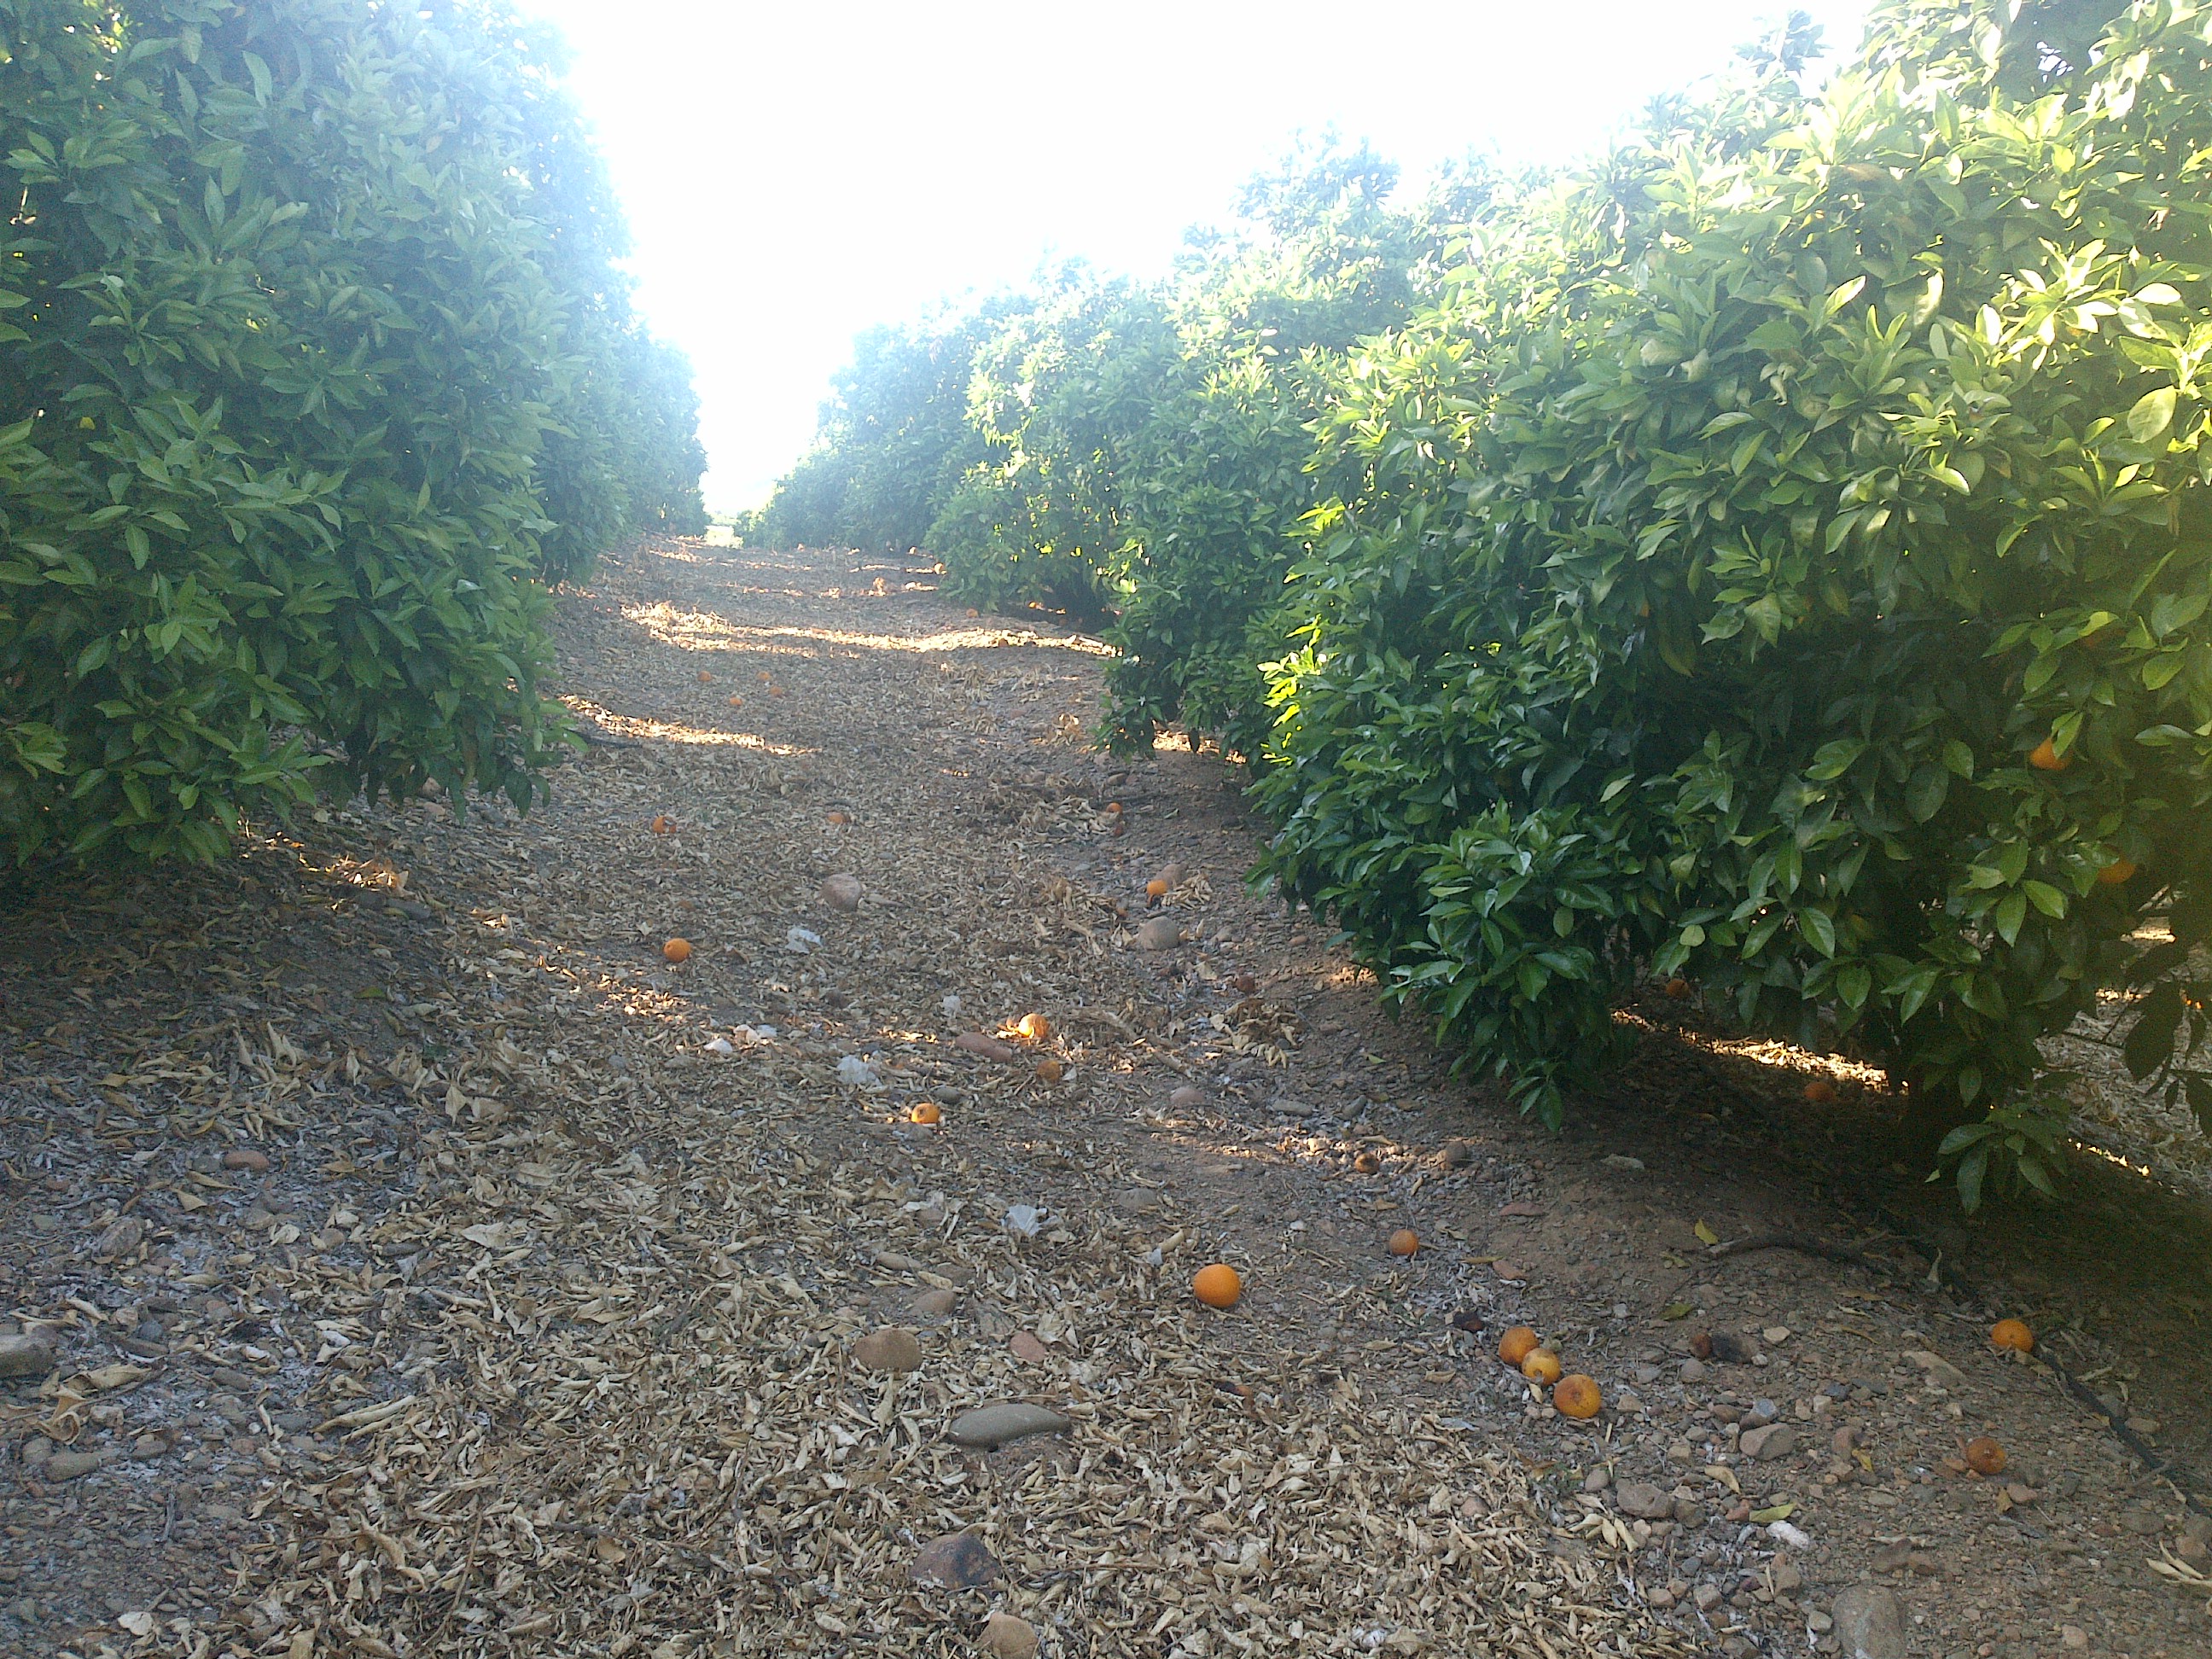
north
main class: Cropland
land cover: Oranges
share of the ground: > 75 %
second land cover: Other bare soil
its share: > 75 %
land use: Agriculture (excluding fallow land and kitchen gardens)
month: May
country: ES
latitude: 37.8021
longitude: -5.2270
